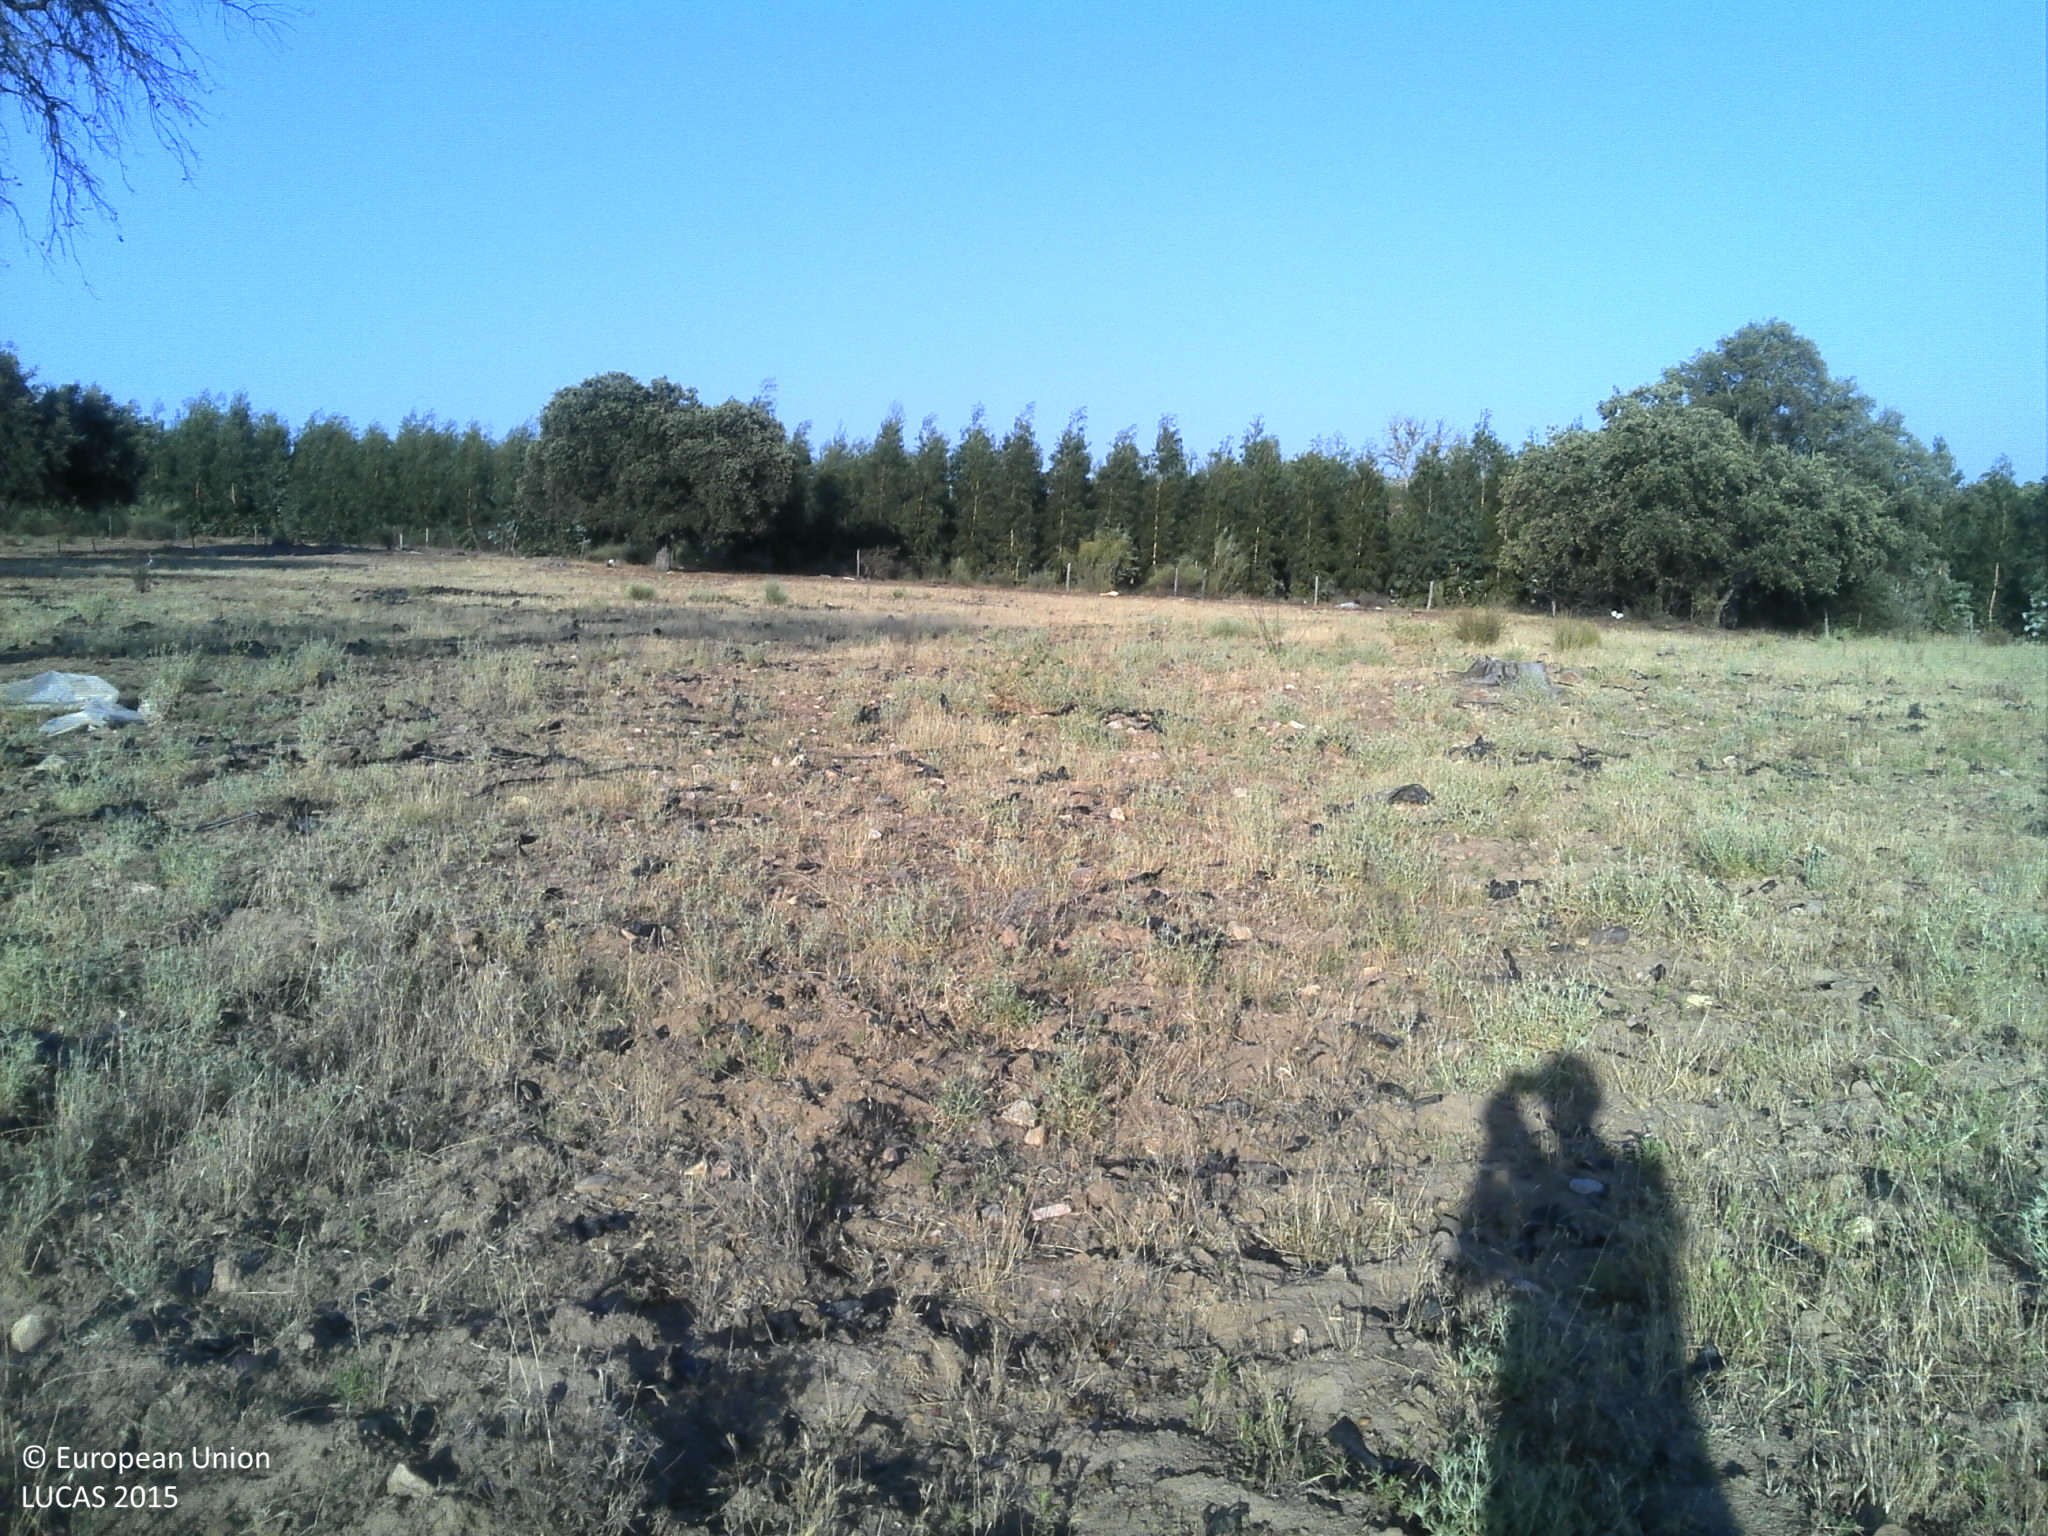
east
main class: Grassland
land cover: Grassland with sparse tree/shrub cover
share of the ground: 50 - 75 %
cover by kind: herbaceous plants 75 %, unconsolidated bare surface 15 %, broadleaved forest trees 5 %, shrubs 5 %
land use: Agriculture (excluding fallow land and kitchen gardens)
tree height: > 5 m
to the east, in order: Grassland with sparse tree/shrub cover; Fences; Grassland with sparse tree/shrub cover; Fences; Tracks; Broadleaved woodland
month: June
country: PT
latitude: 39.8102
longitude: -7.2763
